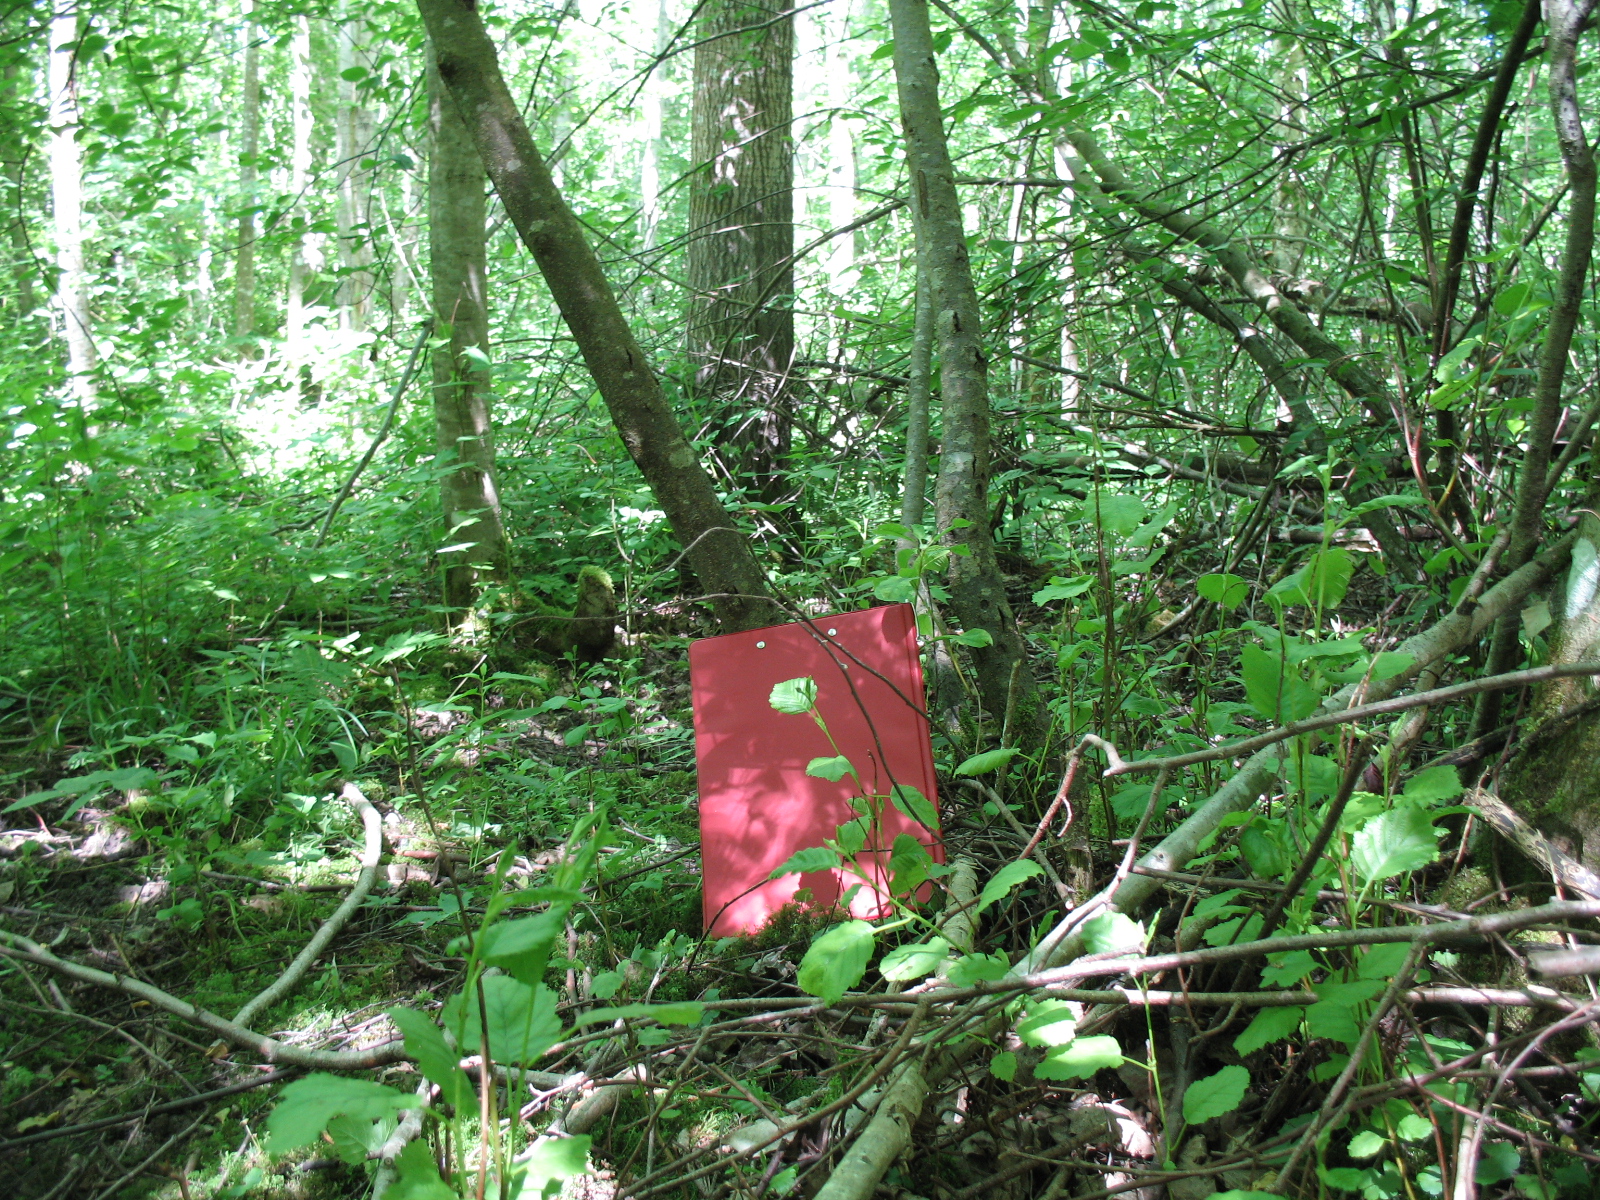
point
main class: Woodland
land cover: Broadleaved woodland
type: non-riverine alder, birch or aspen forest
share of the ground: > 75 %
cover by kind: broadleaved forest trees 100 %
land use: Forestry
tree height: > 5 m
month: June
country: LV
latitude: 56.5162
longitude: 23.4496
